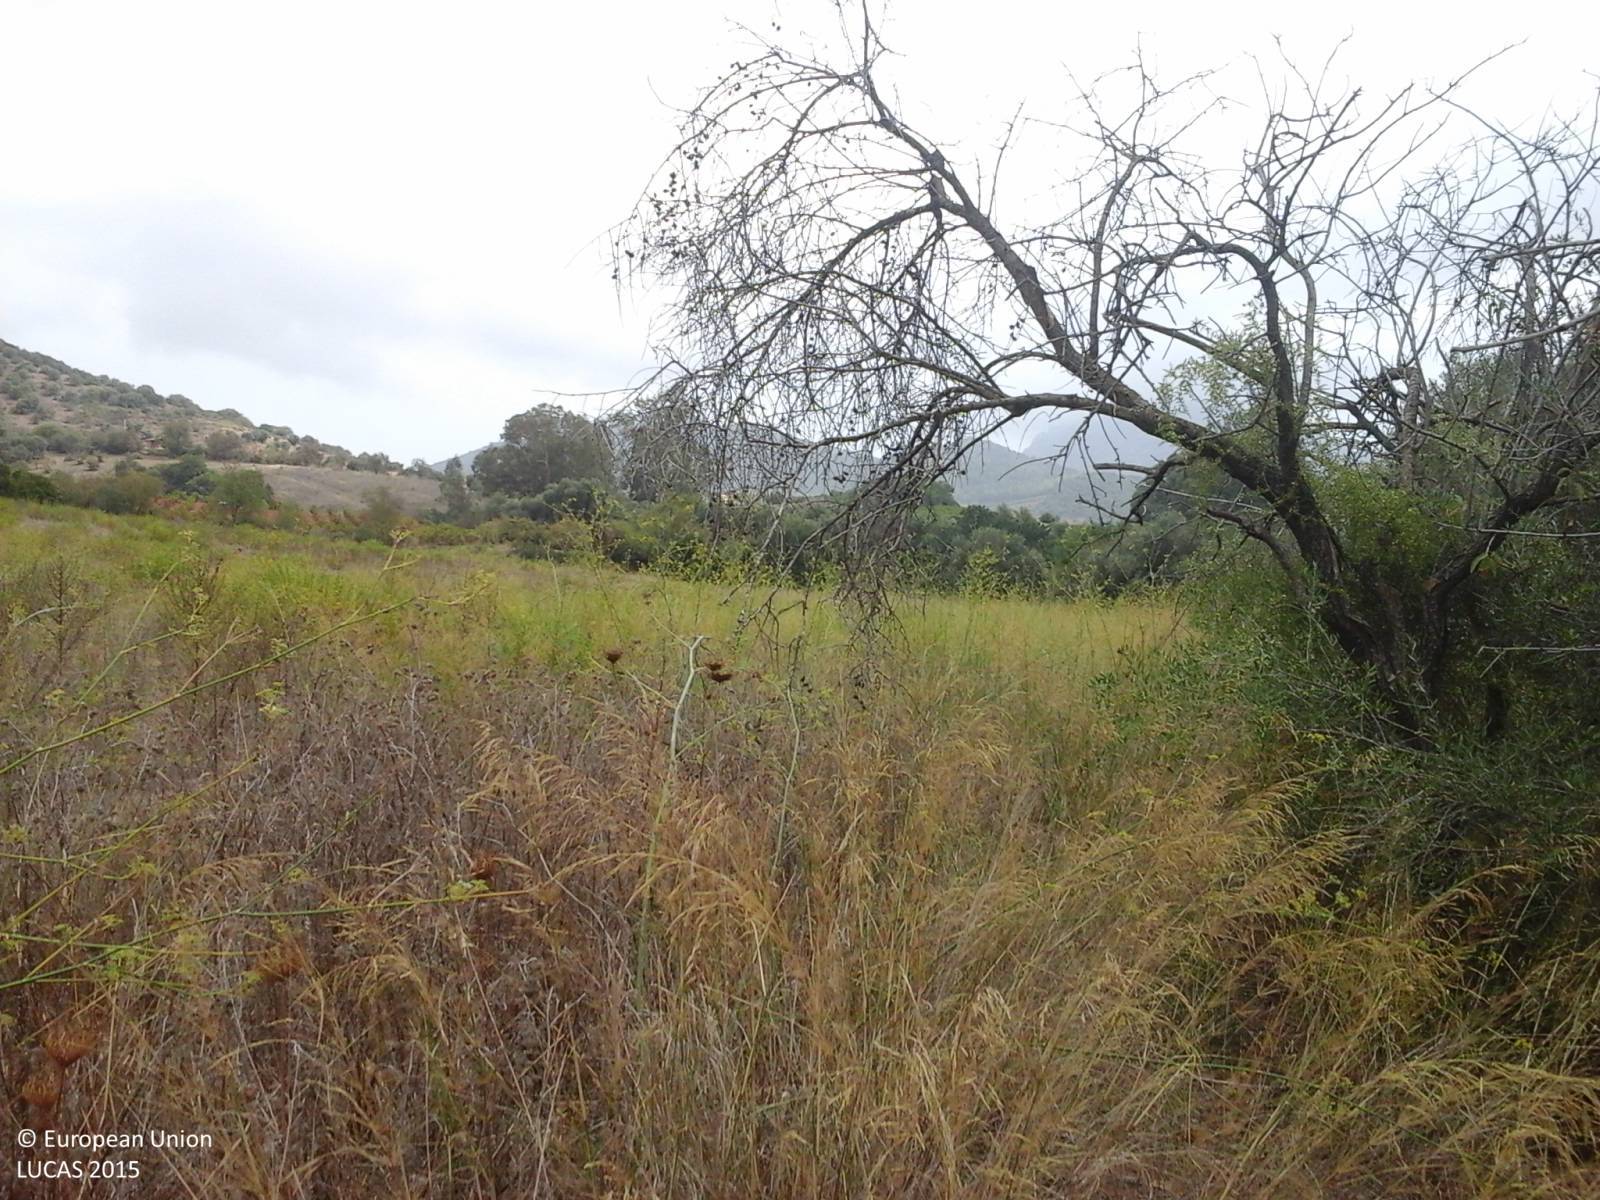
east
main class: Grassland
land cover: Spontaneously vegetated surfaces
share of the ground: > 75 %
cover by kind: herbaceous plants 80 %, unconsolidated bare surface 15 %, consolidated bare surface 5 %
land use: Agriculture (excluding fallow land and kitchen gardens)
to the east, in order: Spontaneously vegetated surfaces; Abandoned hedges; Fences; Grassland with sparse tree/shrub cover; Broadleaved woodland
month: September
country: IT
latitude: 39.7776
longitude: 9.5937
